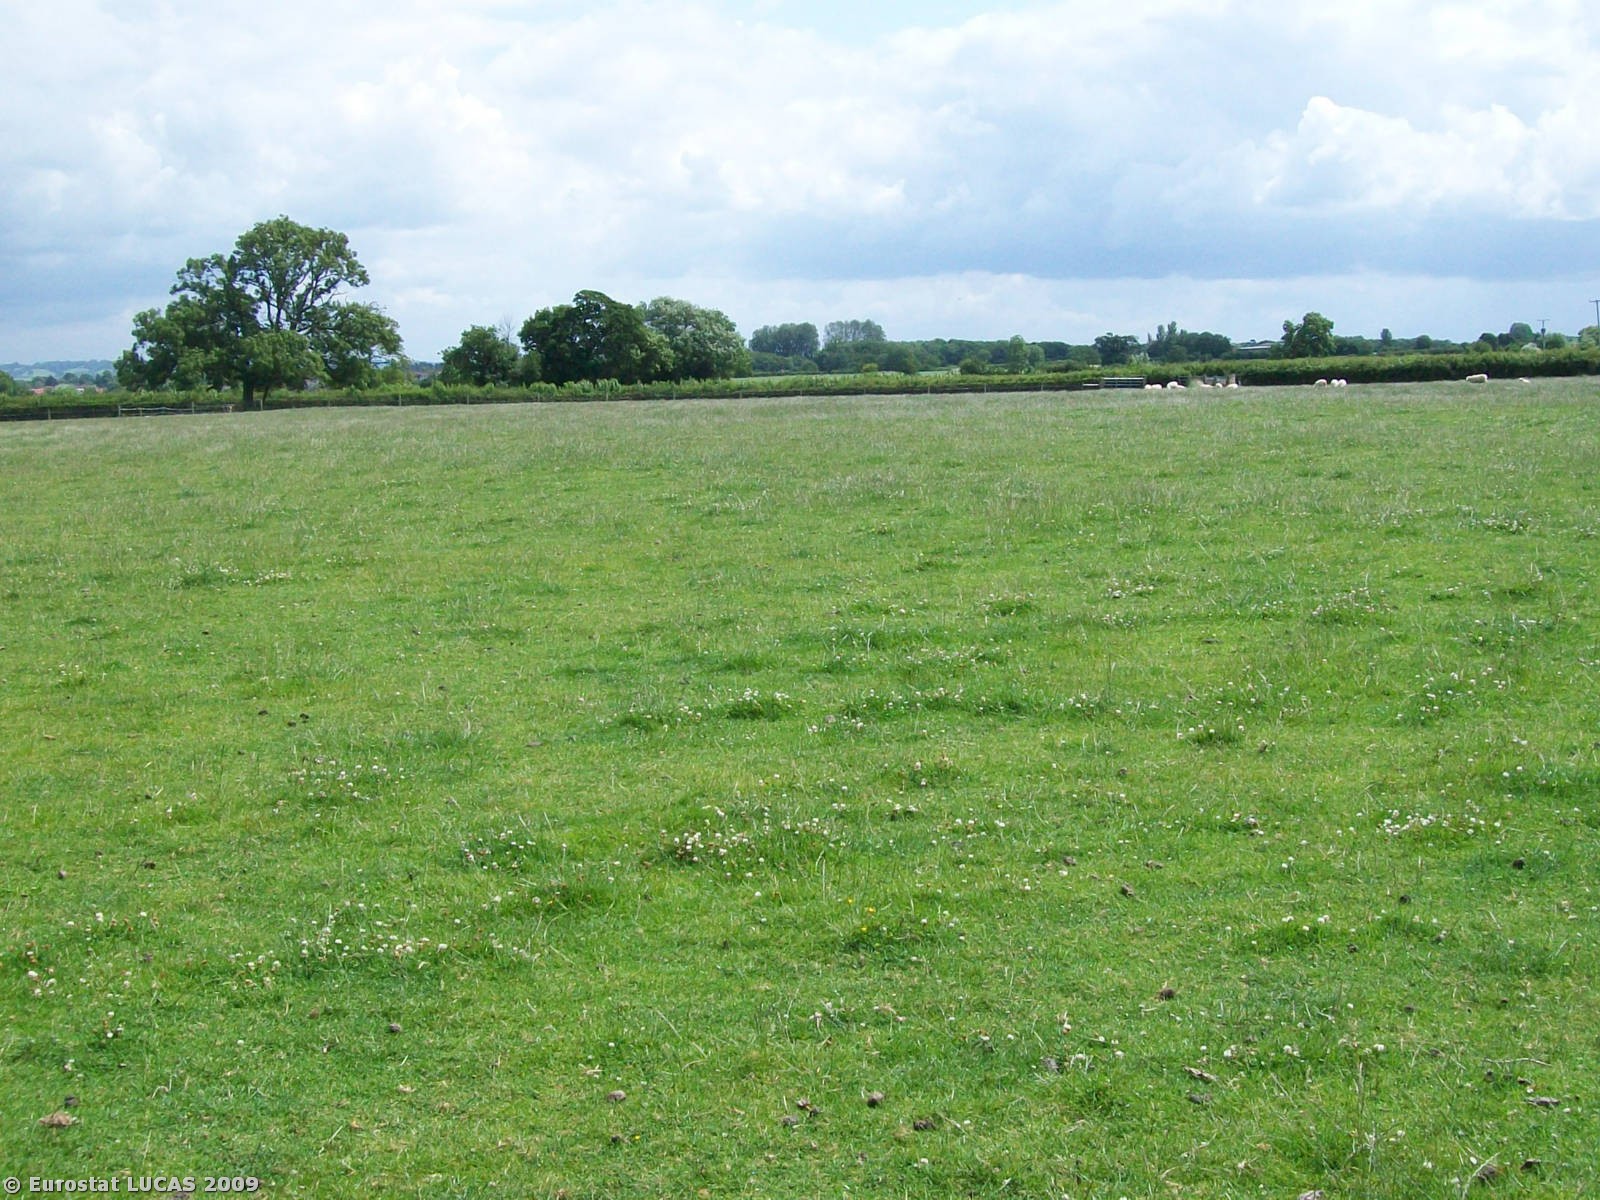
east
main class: Grassland
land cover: Grassland without tree/shrub cover
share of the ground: > 75 %
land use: Agriculture (excluding fallow land and kitchen gardens)
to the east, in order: Grassland without tree/shrub cover; Fences; Grassland without tree/shrub cover; Managed hedges; Ditches and canals; Grass margins; Paved roads, cycling and walking lanes
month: July
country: GB
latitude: 51.1195
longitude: -2.7717
